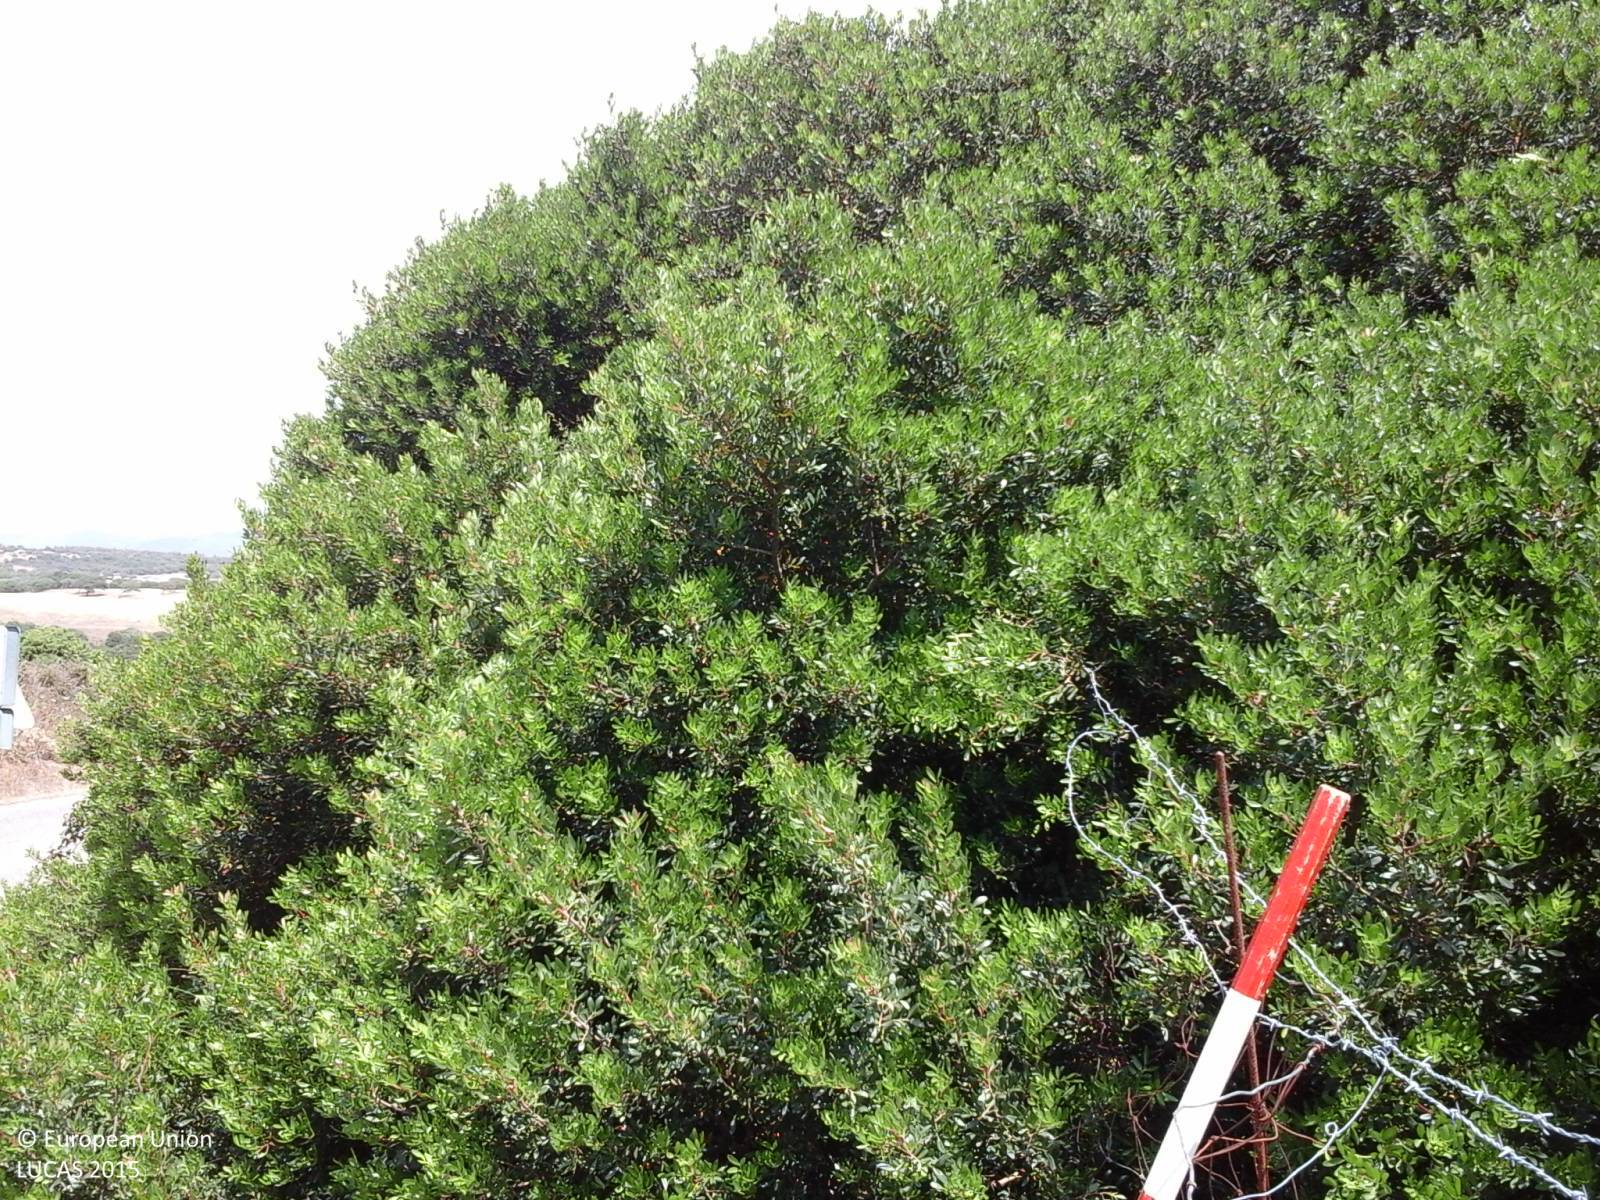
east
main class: Grassland
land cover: Grassland without tree/shrub cover
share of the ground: > 75 %
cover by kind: herbaceous plants 100 %
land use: Agriculture (excluding fallow land and kitchen gardens)
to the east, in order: Grassland without tree/shrub cover; Abandoned hedges; Other leguminous and mixtures for fodder; Dry stone walls; Other bare soil; Dry pulses; Fences; Grass margins; Paved roads, cycling and walking lanes; Fences; Olive groves; Vineyards; Durum wheat
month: June
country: IT
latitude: 39.8627
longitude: 8.8956
